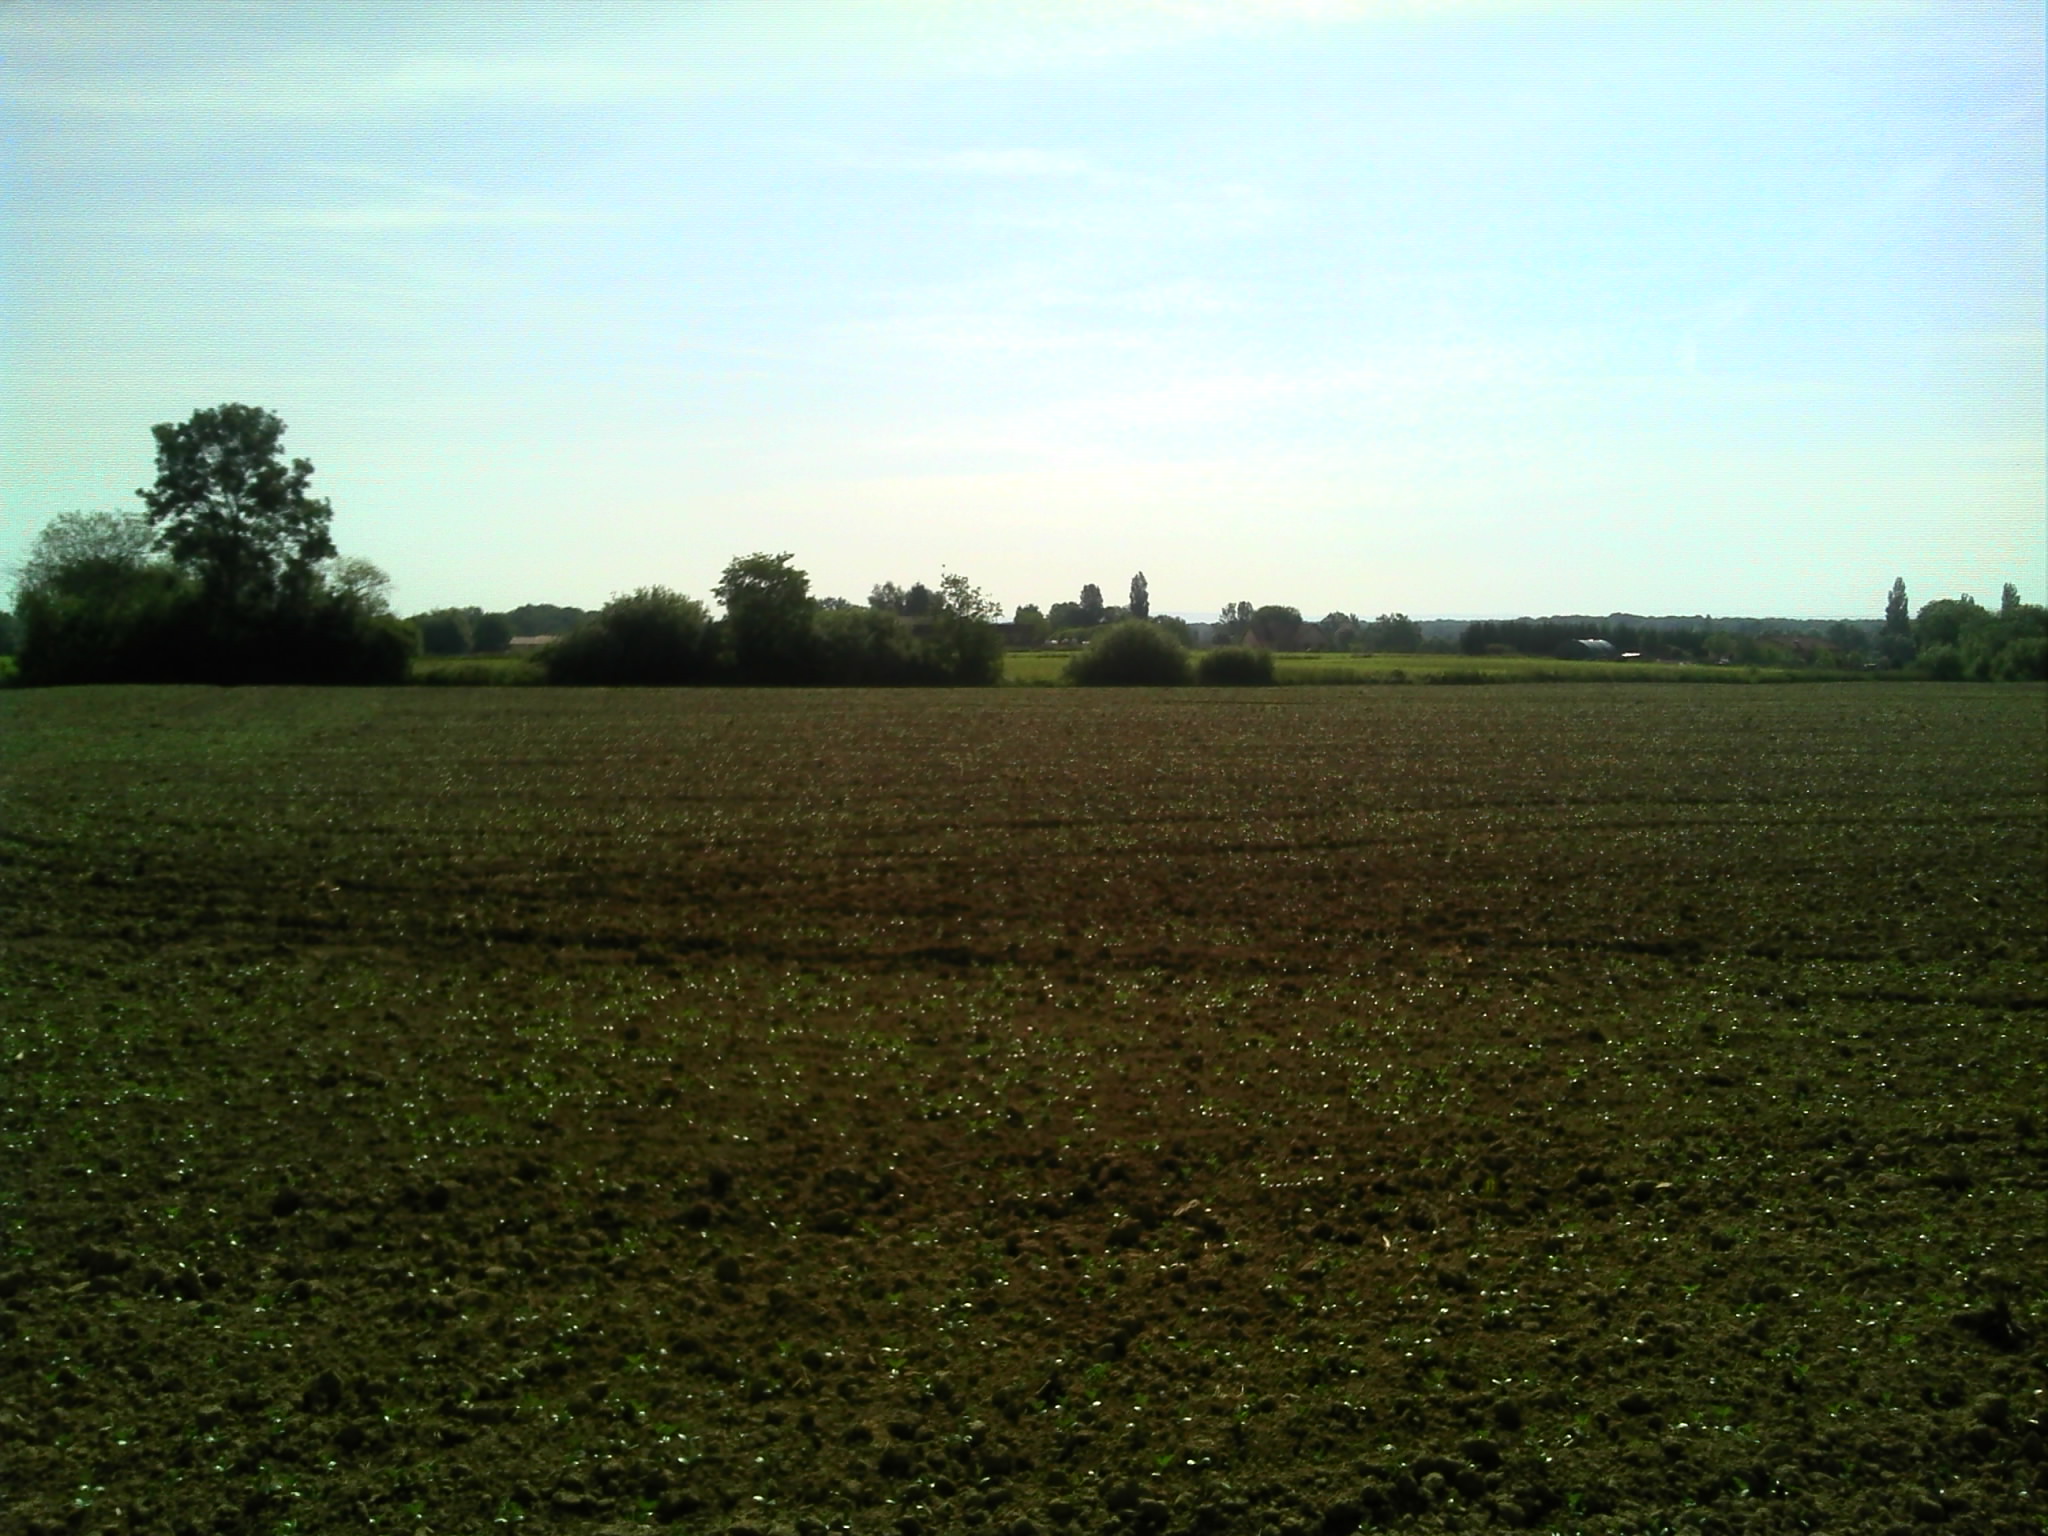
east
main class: Cropland
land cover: Soya
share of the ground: < 10 %
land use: Agriculture (excluding fallow land and kitchen gardens)
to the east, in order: Soya; Managed hedges; Maize; Ditches and canals; Maize
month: May
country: FR
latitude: 46.5606
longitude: 5.0320
